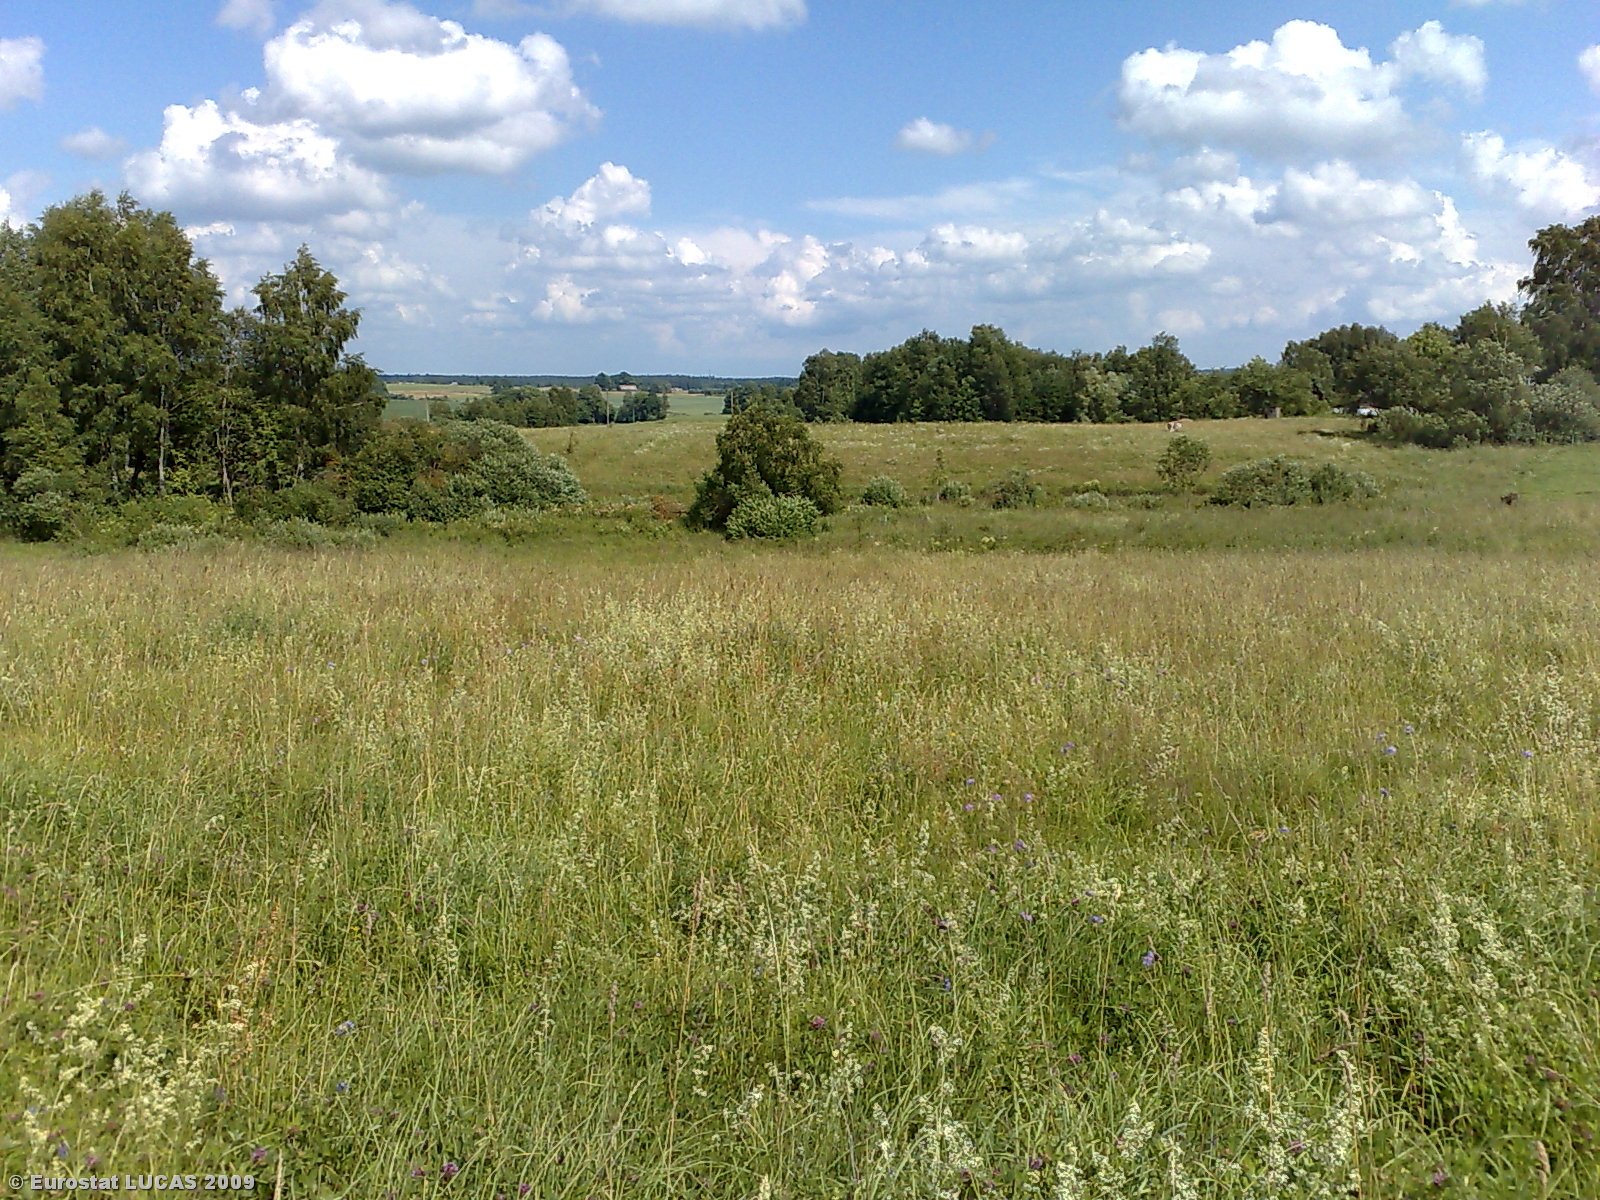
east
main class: Grassland
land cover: Grassland without tree/shrub cover
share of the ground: > 75 %
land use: Agriculture (excluding fallow land and kitchen gardens)
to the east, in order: Grassland without tree/shrub cover; Grassland with sparse tree/shrub cover; Grassland without tree/shrub cover; Potatoes; Grassland without tree/shrub cover
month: July
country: LT
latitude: 55.5681
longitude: 22.7354
